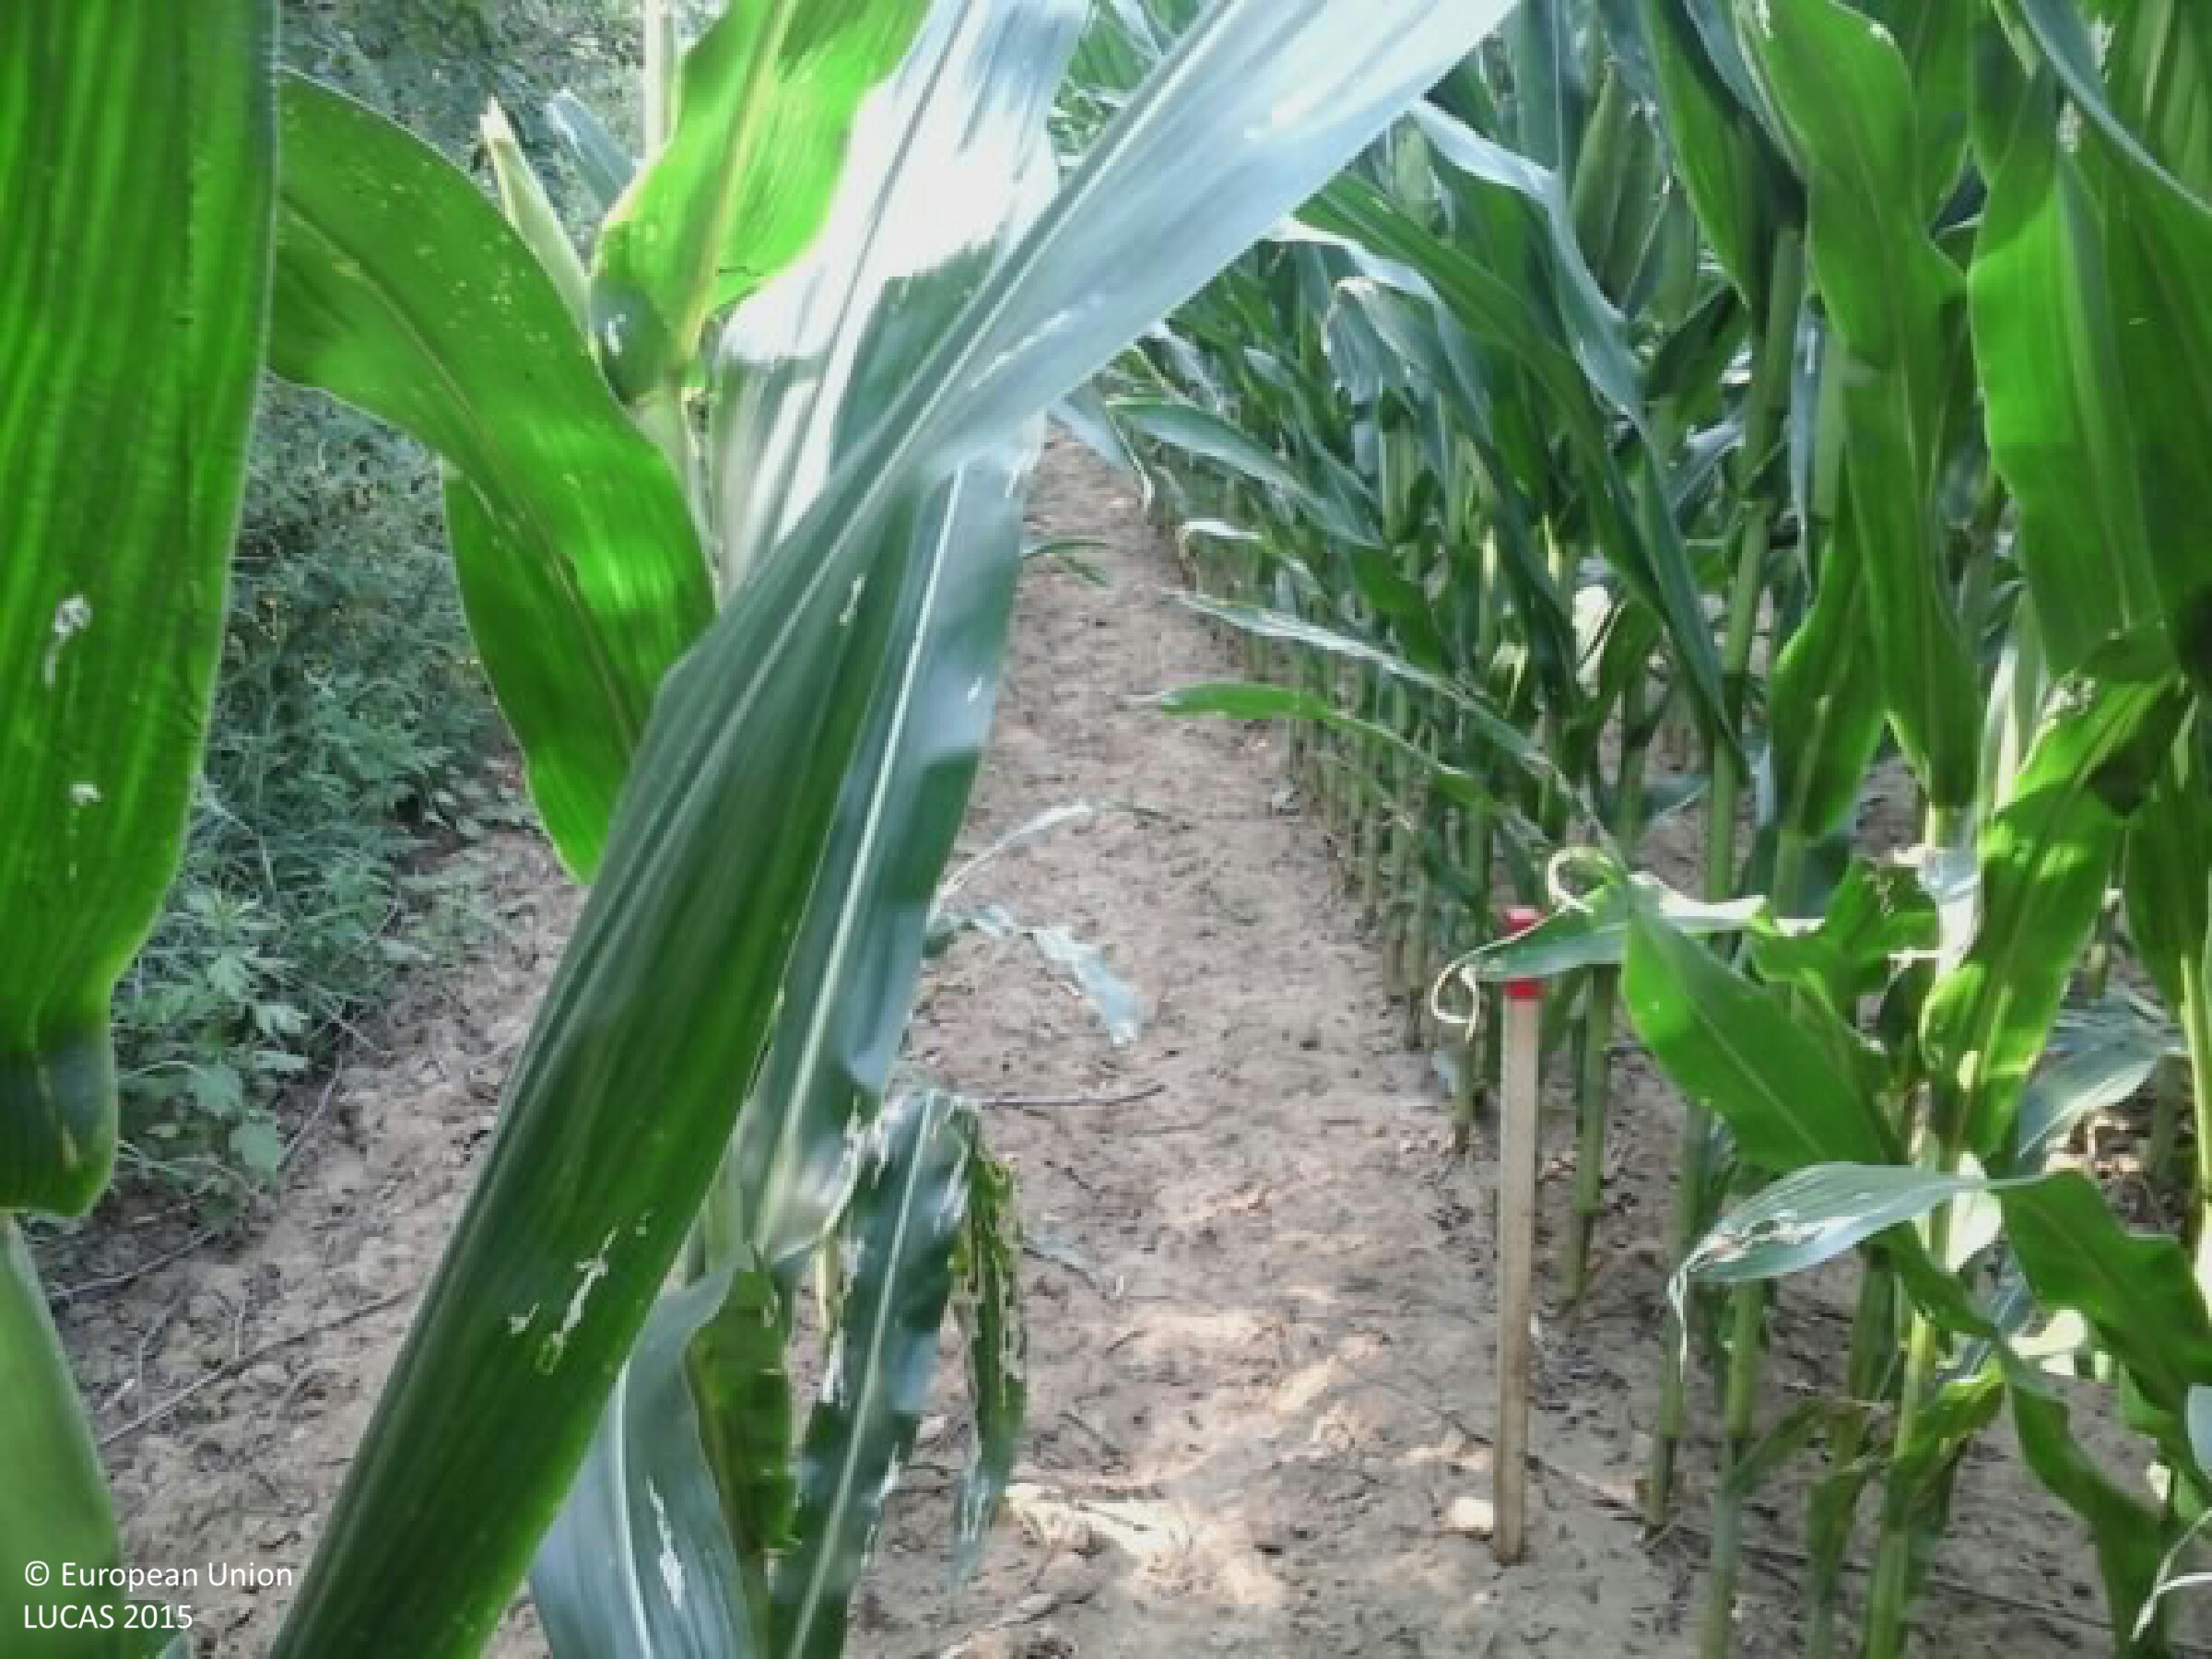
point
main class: Cropland
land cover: Maize
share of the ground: > 75 %
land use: Agriculture (excluding fallow land and kitchen gardens)
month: August
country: HU
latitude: 46.4682
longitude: 17.9901
